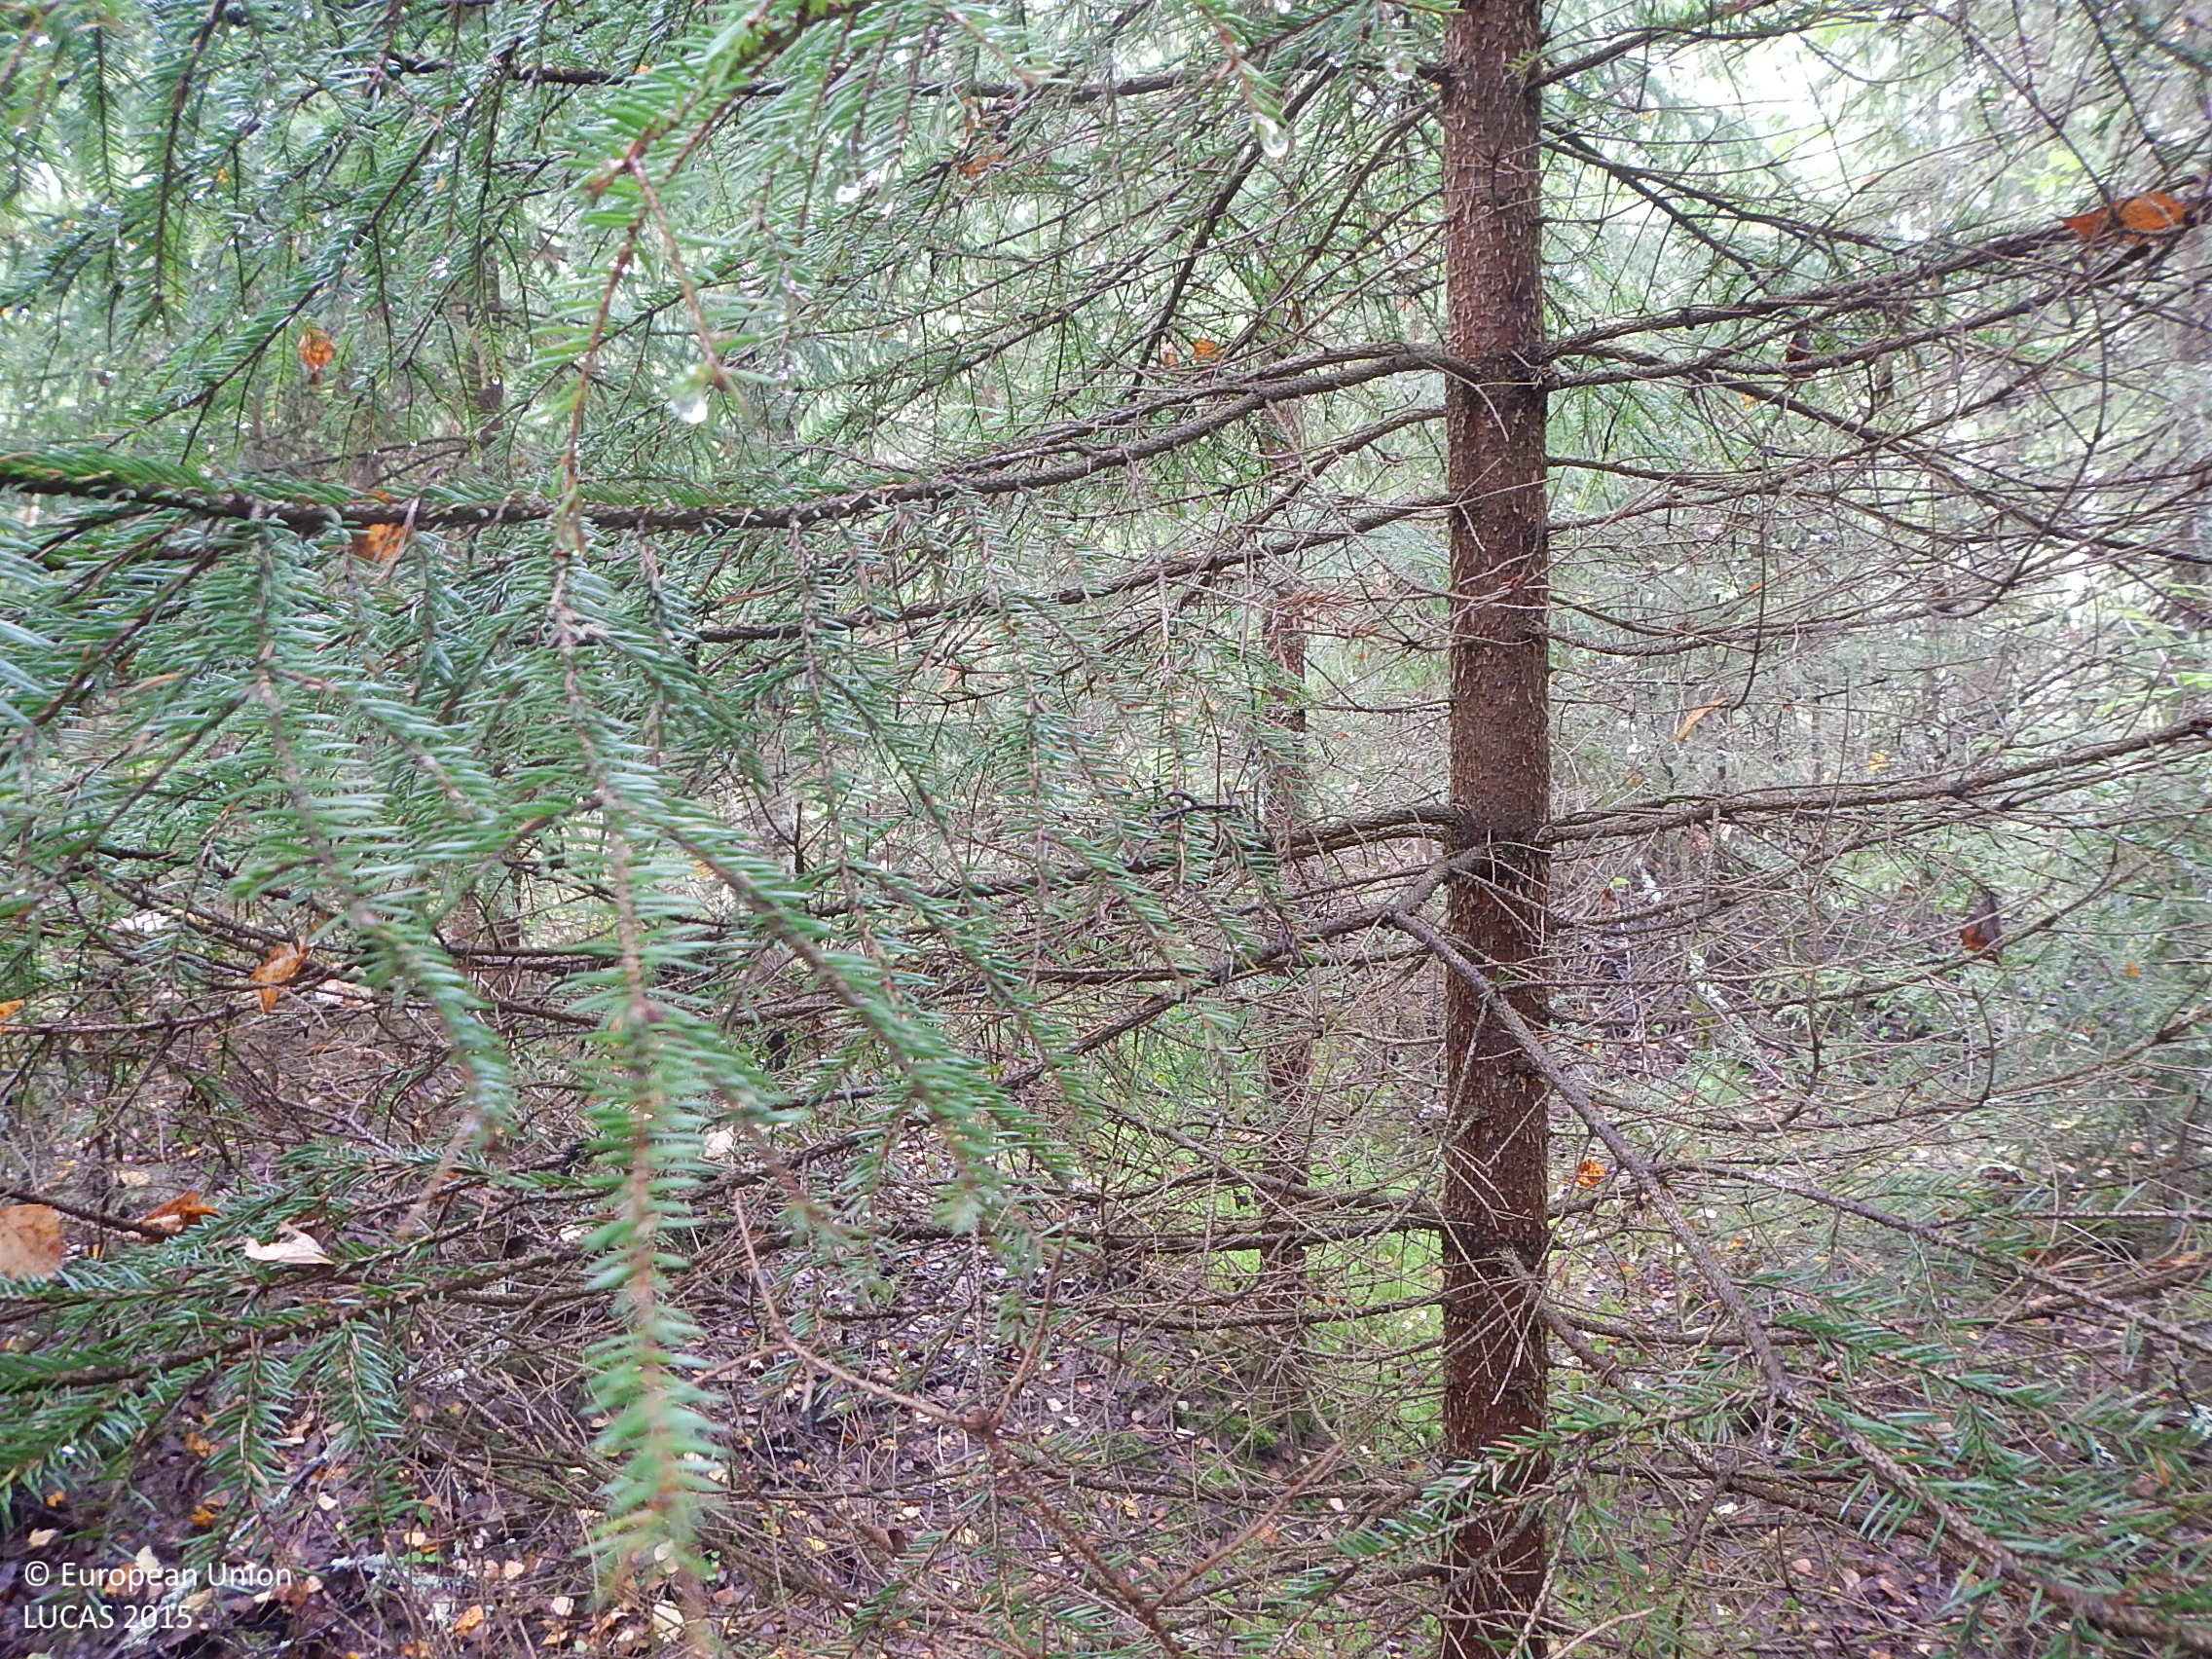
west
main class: Woodland
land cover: Other mixed woodland
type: boreal forest
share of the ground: > 75 %
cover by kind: coniferous forest trees 65 %, broadleaved forest trees 30 %, lichens and mosses 5 %
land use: Forestry
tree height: > 5 m
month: September
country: FI
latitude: 61.4566
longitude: 23.0355
